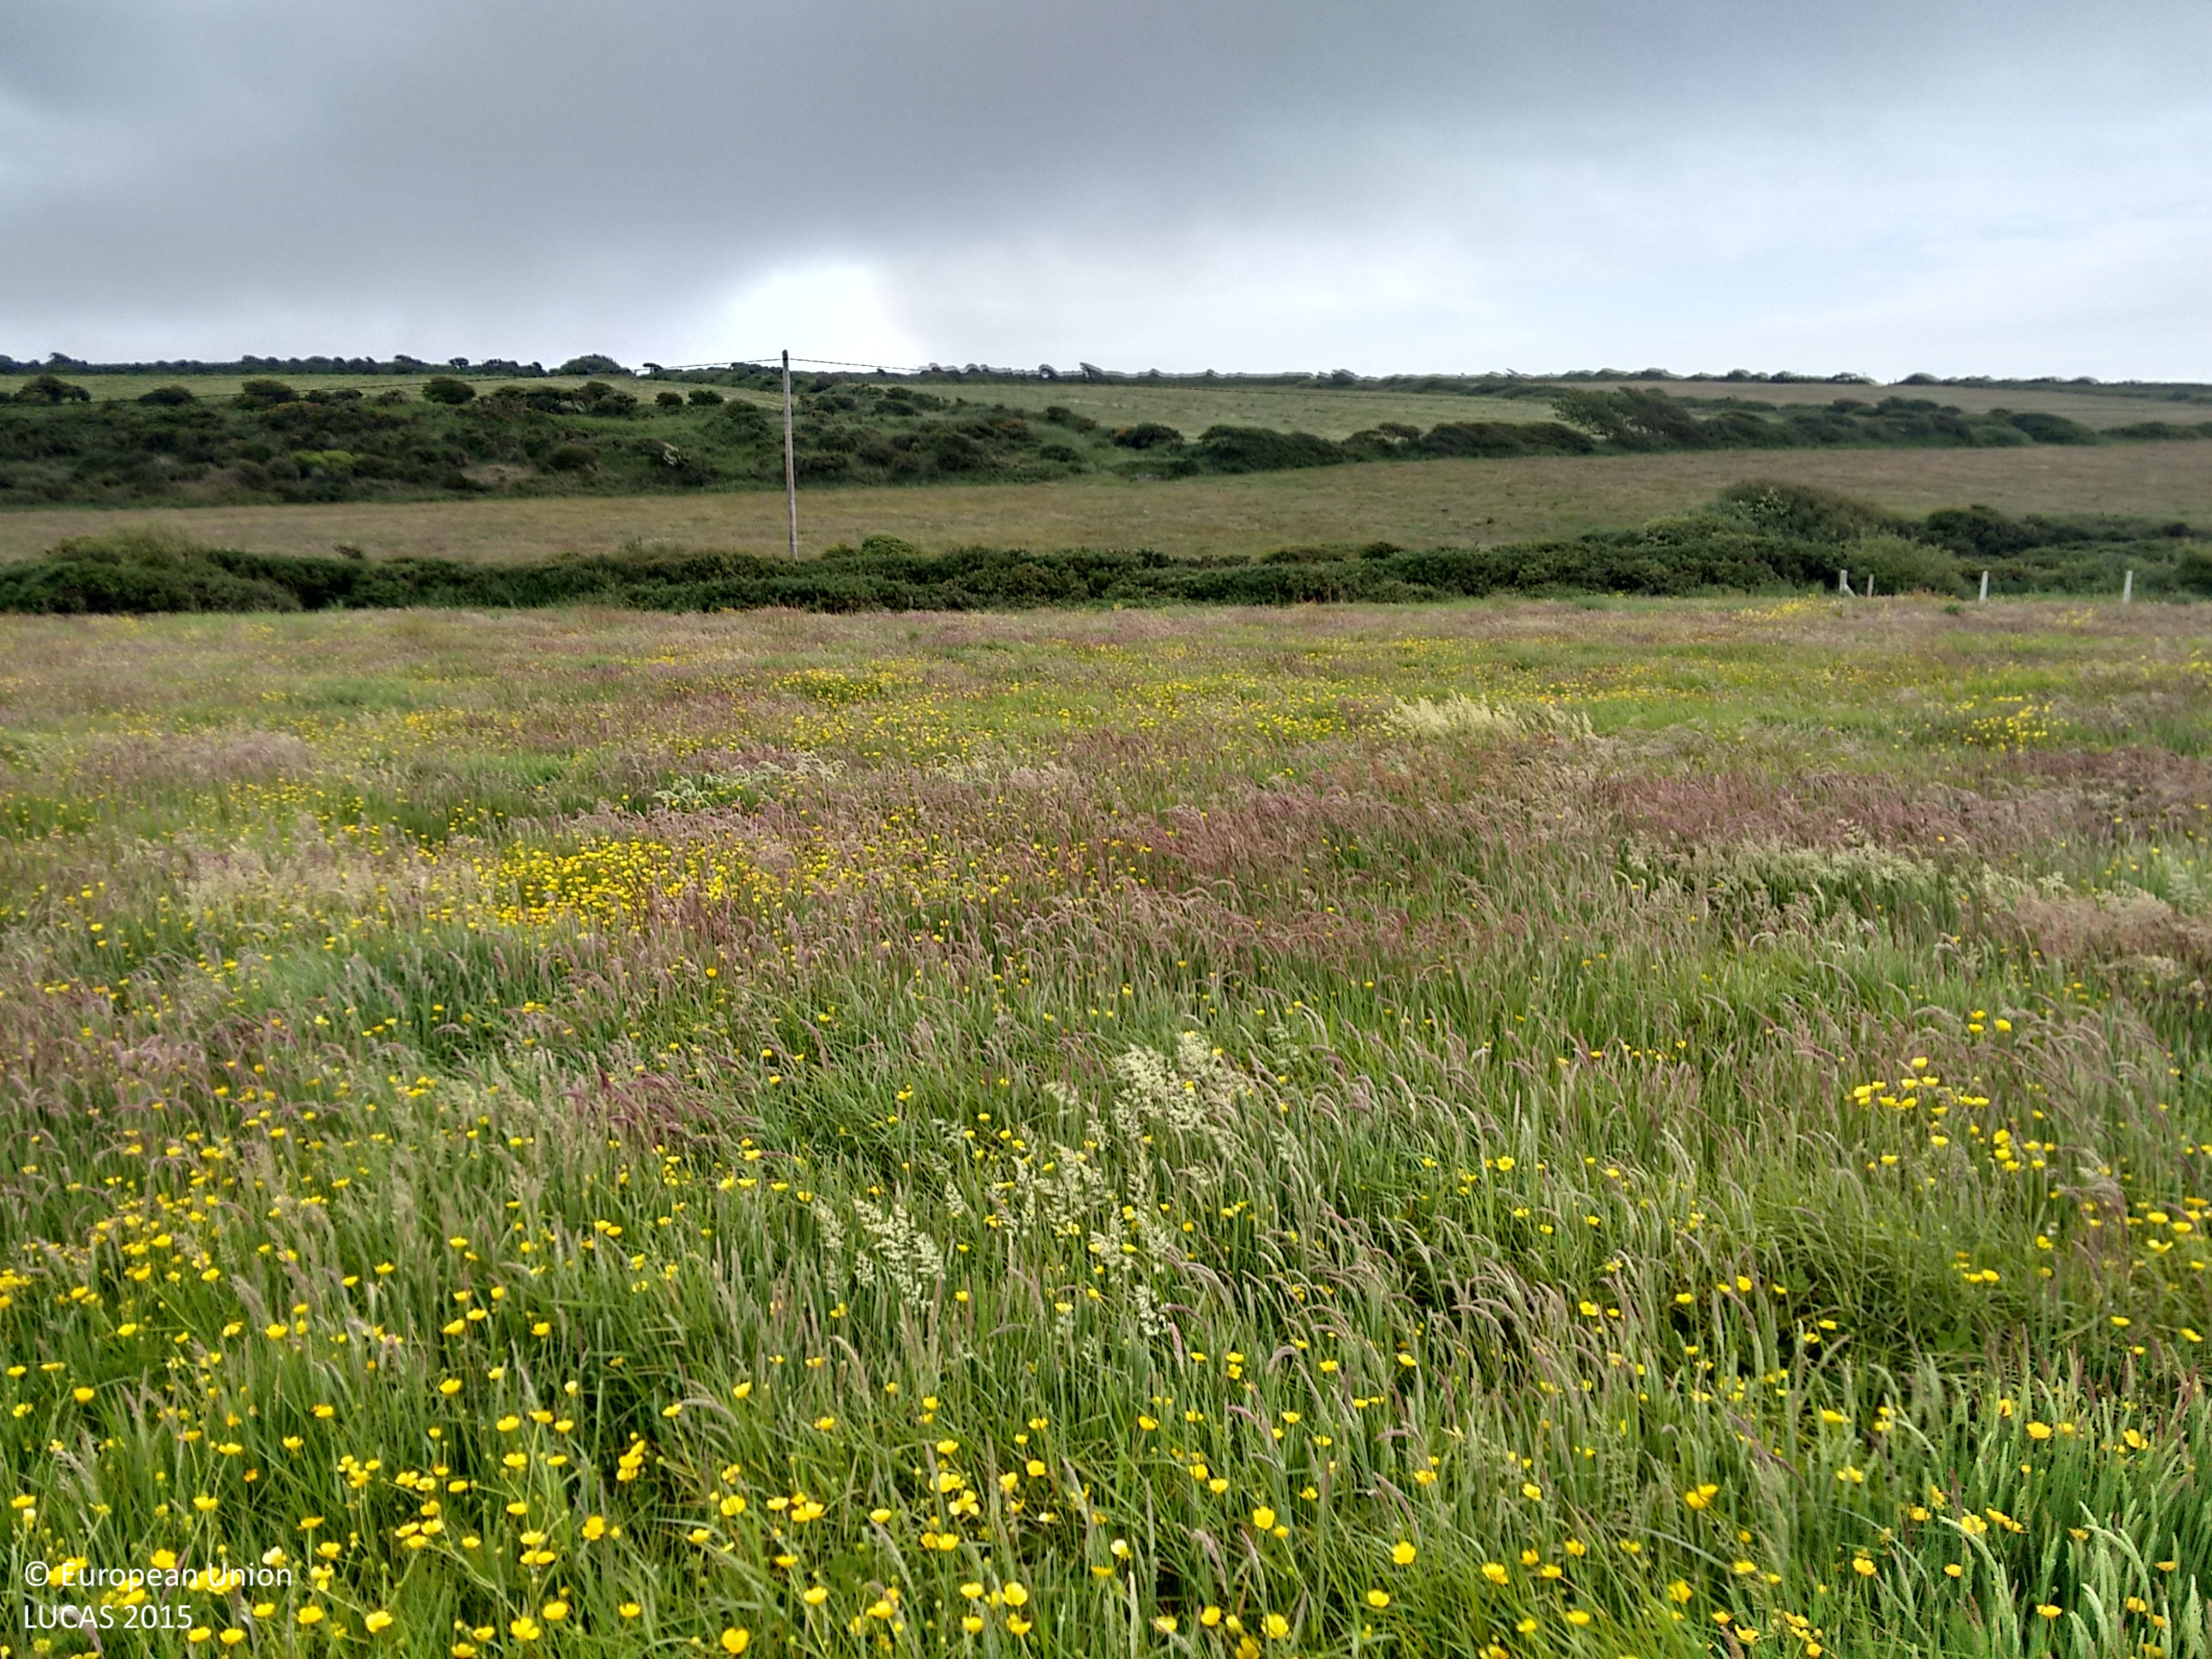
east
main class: Grassland
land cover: Grassland without tree/shrub cover
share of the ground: > 75 %
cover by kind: herbaceous plants 100 %
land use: Agriculture (excluding fallow land and kitchen gardens)
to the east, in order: Grassland without tree/shrub cover; Fences; Ditches and canals; Abandoned hedges; Paved roads, cycling and walking lanes; Electric lines; Abandoned hedges; Grassland without tree/shrub cover; Fences; Abandoned hedges; Ditches and canals; Abandoned hedges; Grassland without tree/shrub cover; Fences; Shrubland without tree cover; Grassland without tree/shrub cover
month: June
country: IE
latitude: 52.1388
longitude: -7.2006
